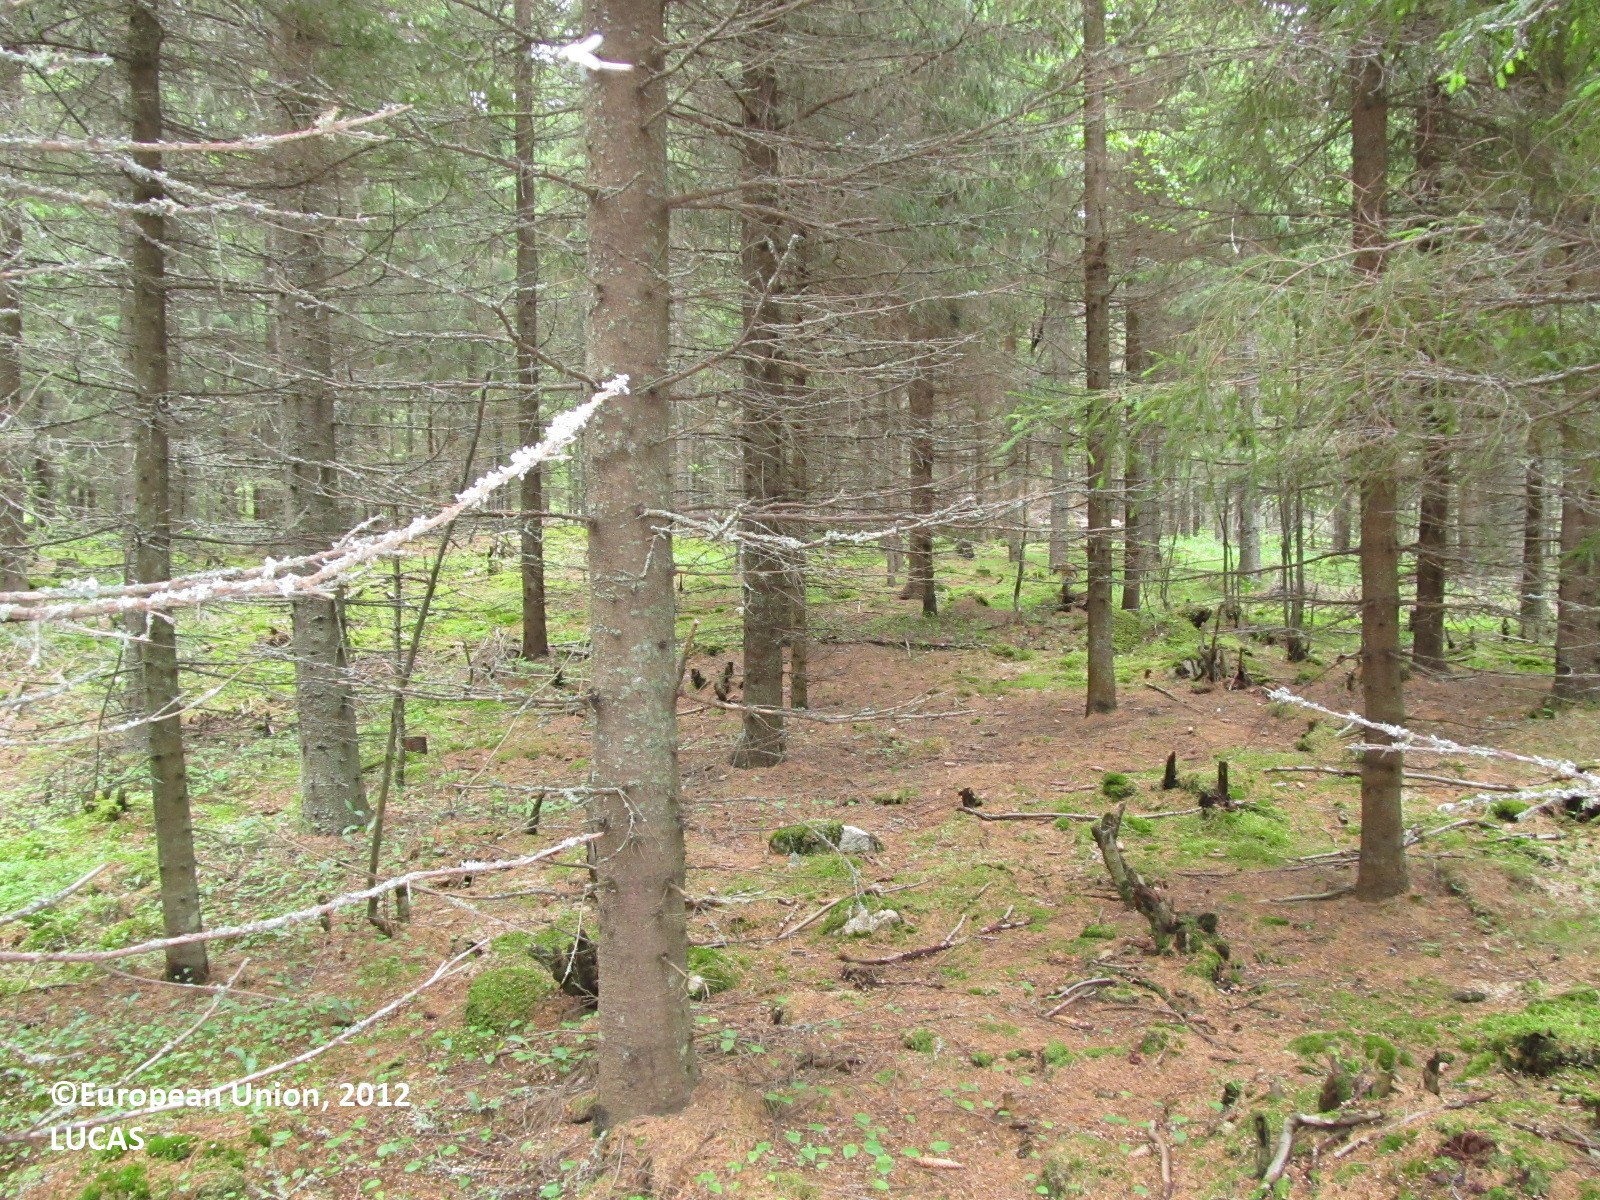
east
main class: Woodland
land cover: Spruce dominated coniferous woodland
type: boreal forest
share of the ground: 50 - 75 %
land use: Forestry
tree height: > 5 m
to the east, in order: Spruce dominated coniferous woodland
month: June
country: FI
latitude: 62.7587
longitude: 28.7519
